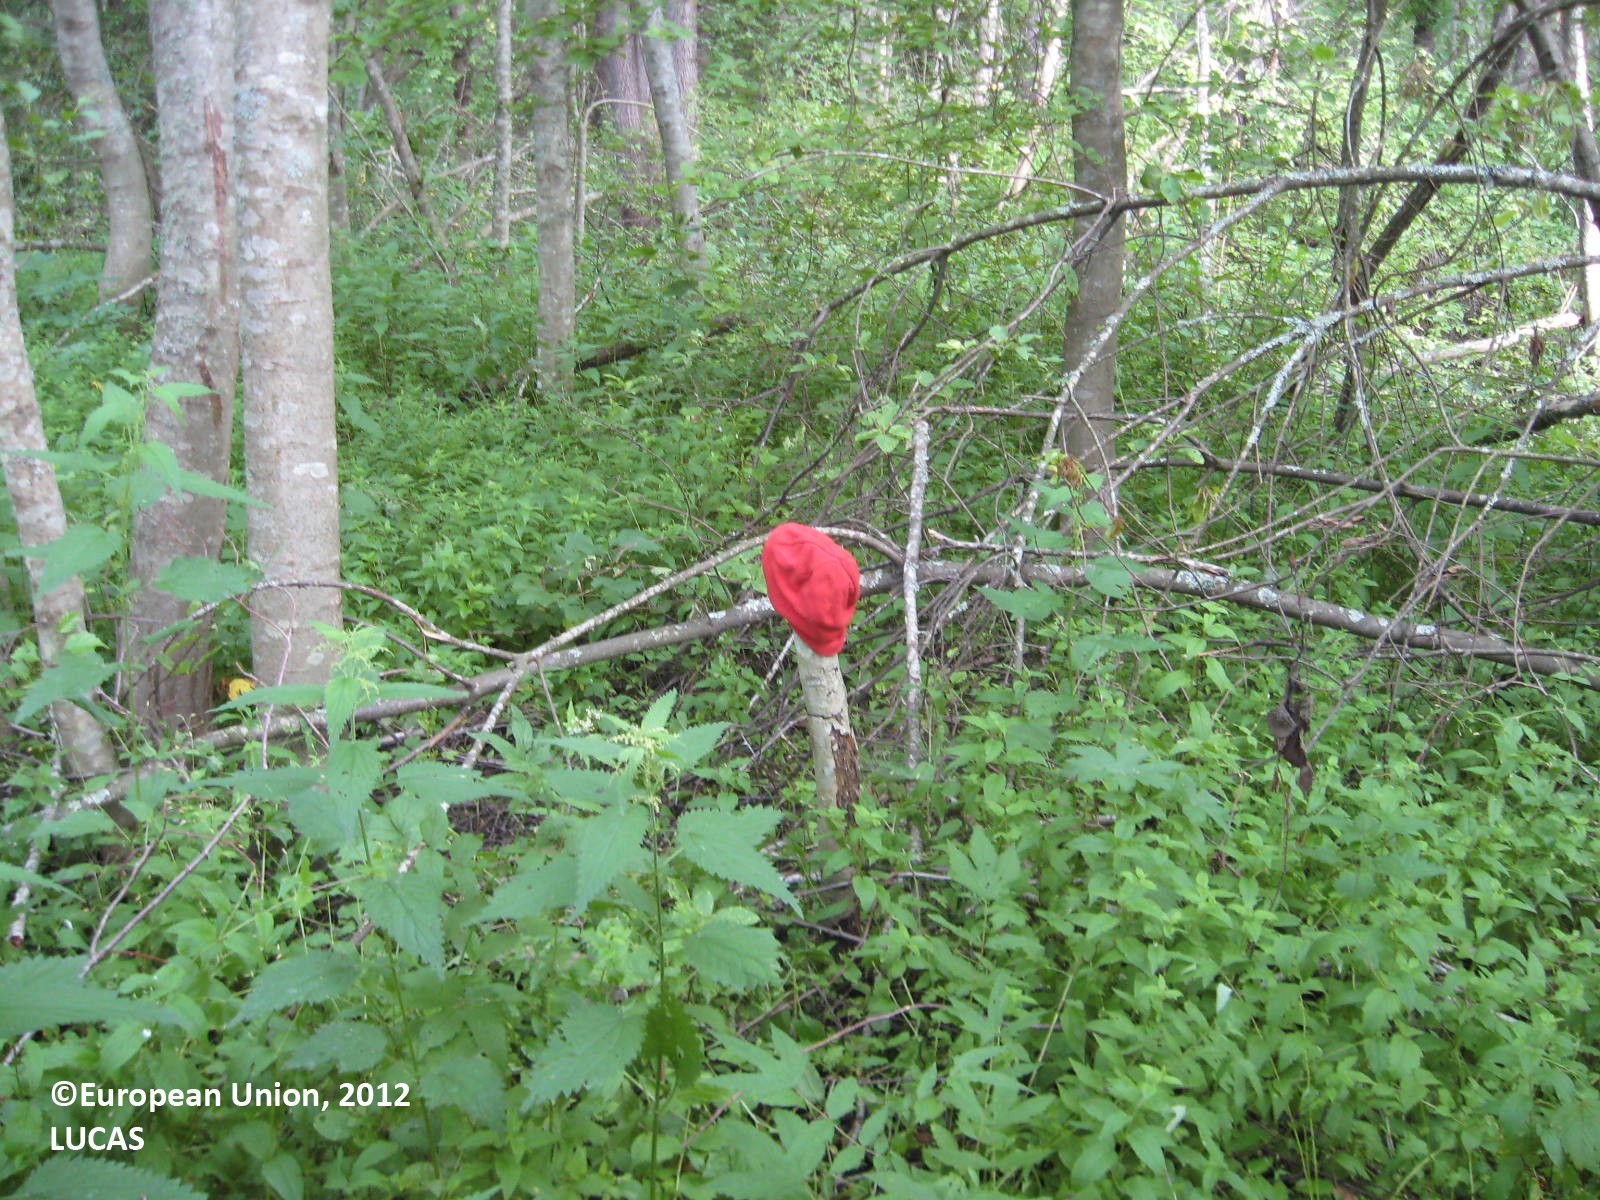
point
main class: Woodland
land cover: Broadleaved woodland
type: boreal forest
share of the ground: > 75 %
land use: Semi-natural and natural areas not in use
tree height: > 5 m
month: July
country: FI
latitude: 62.2347
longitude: 21.6109
